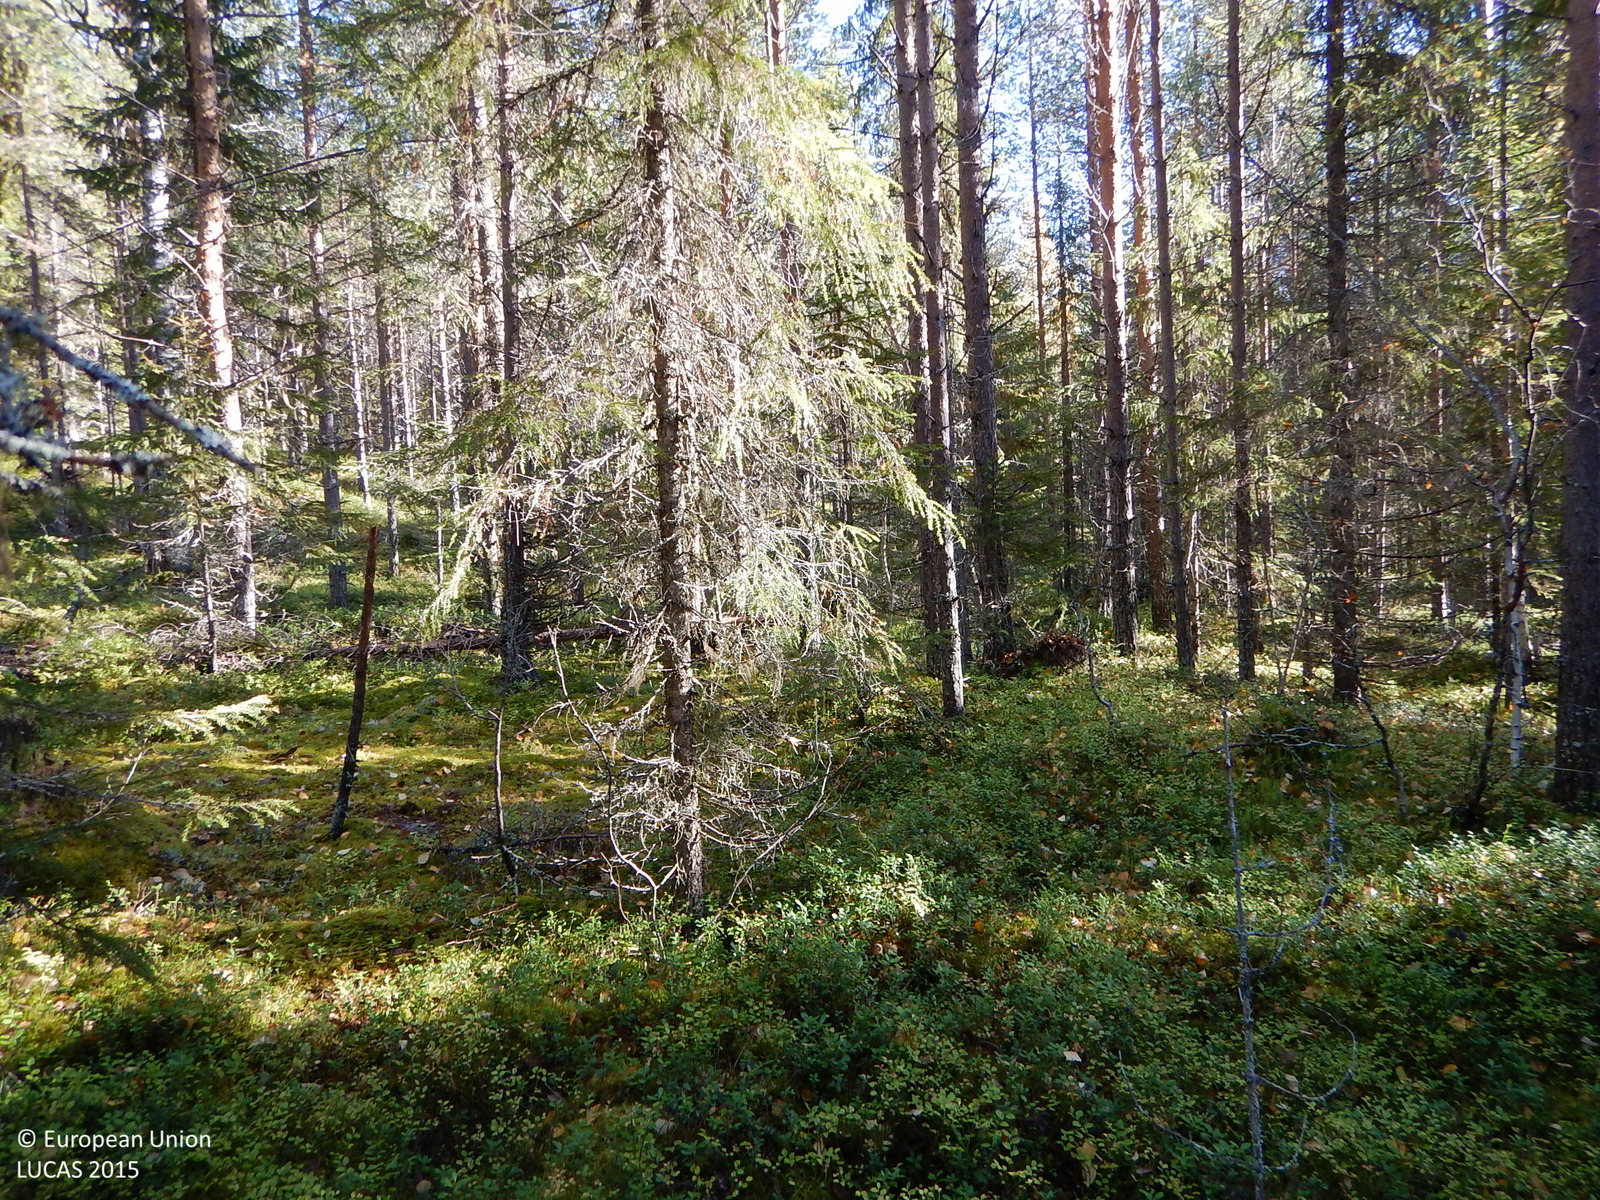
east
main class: Woodland
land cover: Other coniferous woodland
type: boreal forest
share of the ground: 50 - 75 %
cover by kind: coniferous forest trees 70 %, shrubs 15 %, lichens and mosses 10 %, herbaceous plants 5 %
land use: Forestry
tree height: > 5 m
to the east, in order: Other coniferous woodland; Pine dominated coniferous woodland
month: September
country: SE
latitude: 64.9504
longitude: 20.1096
